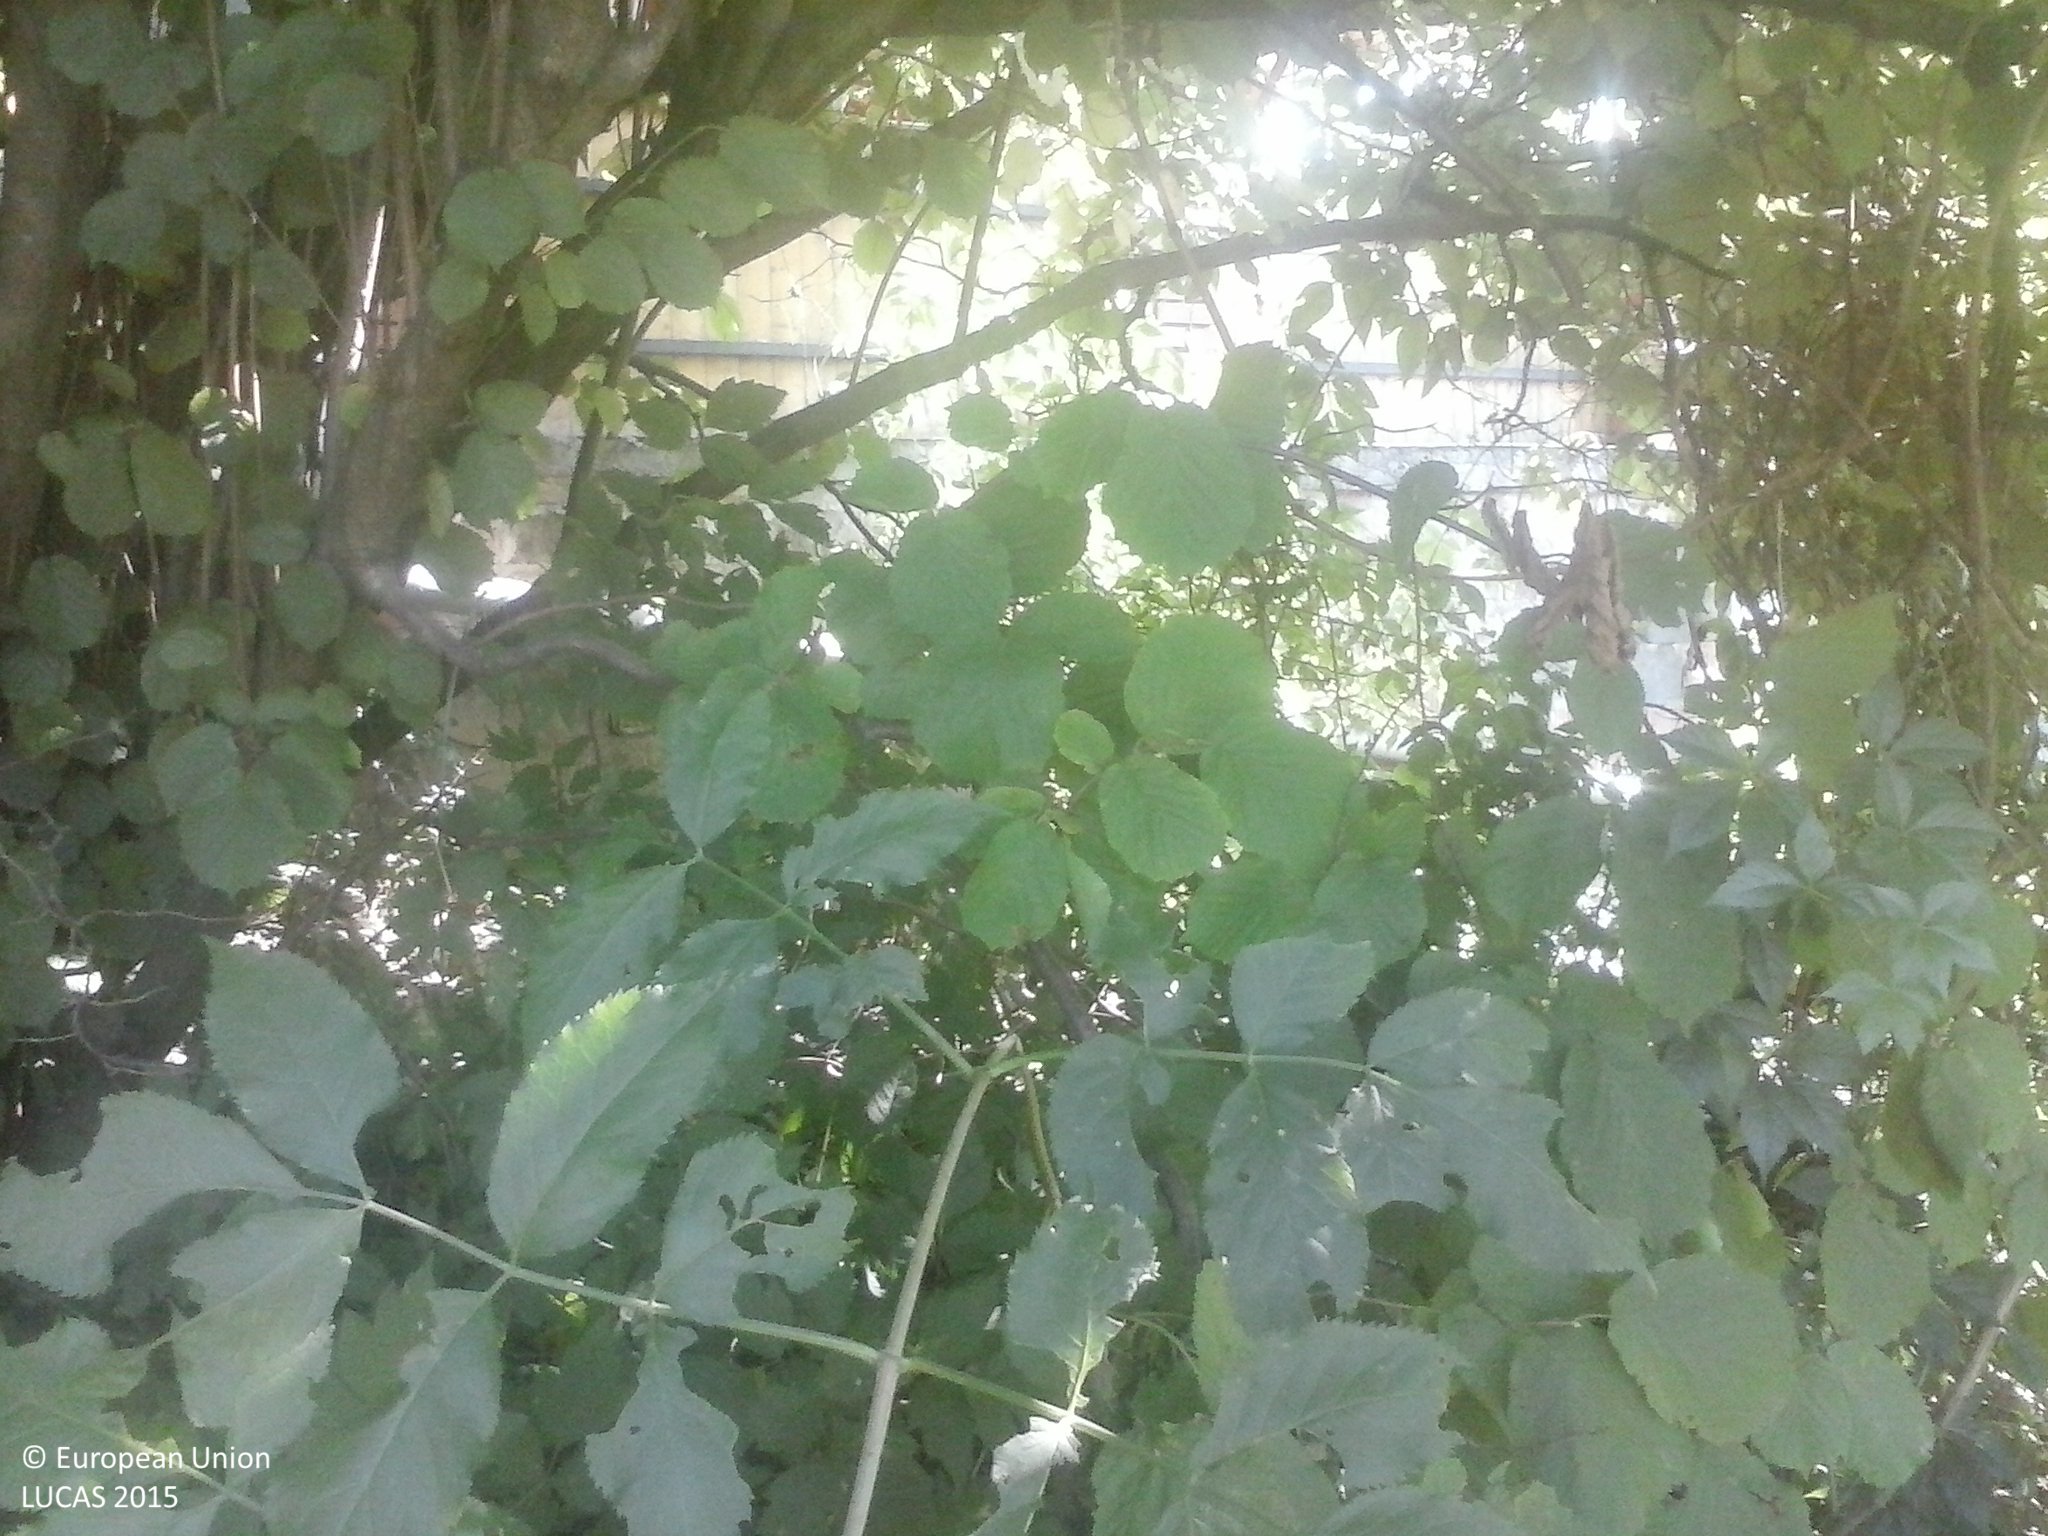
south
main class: Grassland
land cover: Grassland with sparse tree/shrub cover
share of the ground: > 75 %
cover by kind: herbaceous plants 90 %, broadleaved forest trees 5 %, shrubs 5 %
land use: Residential
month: August
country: HU
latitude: 46.0482
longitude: 17.7978
